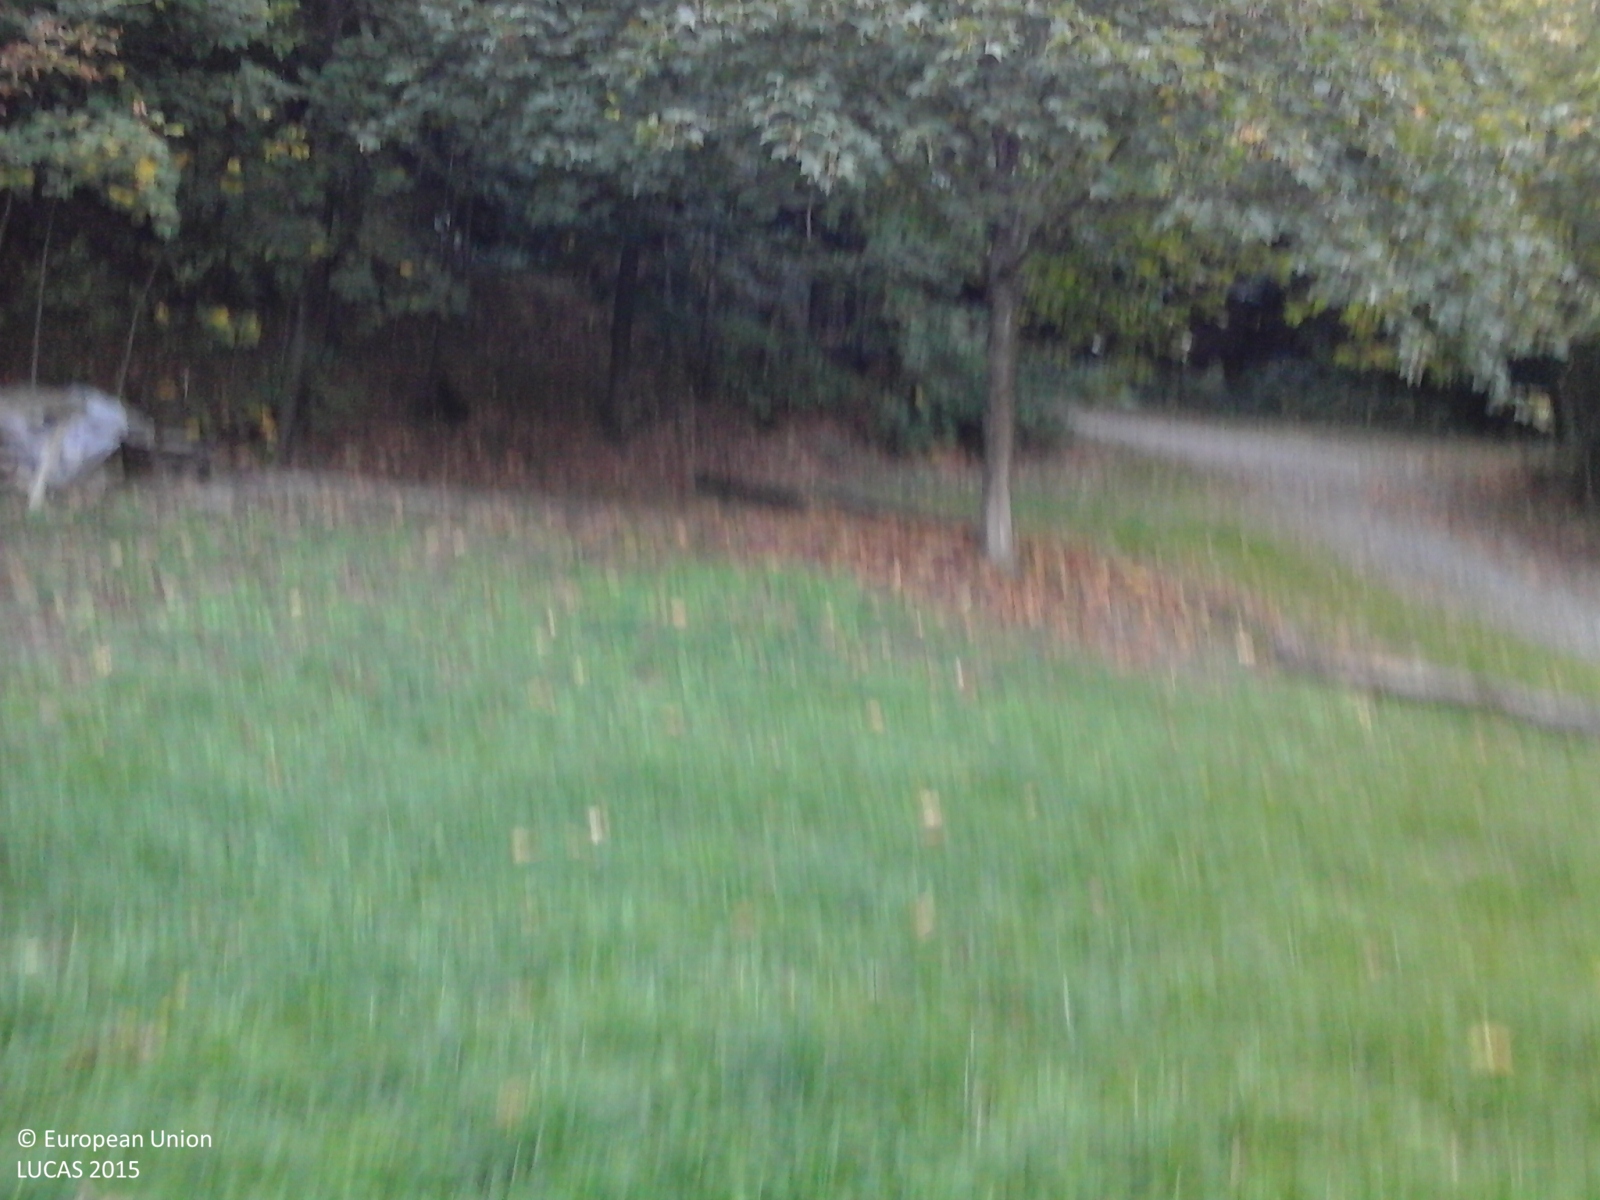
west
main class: Grassland
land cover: Grassland with sparse tree/shrub cover
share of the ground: > 75 %
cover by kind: herbaceous plants 85 %, shrubs 10 %, broadleaved forest trees 5 %
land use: Residential
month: September
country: IT
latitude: 44.4105
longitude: 8.4087
